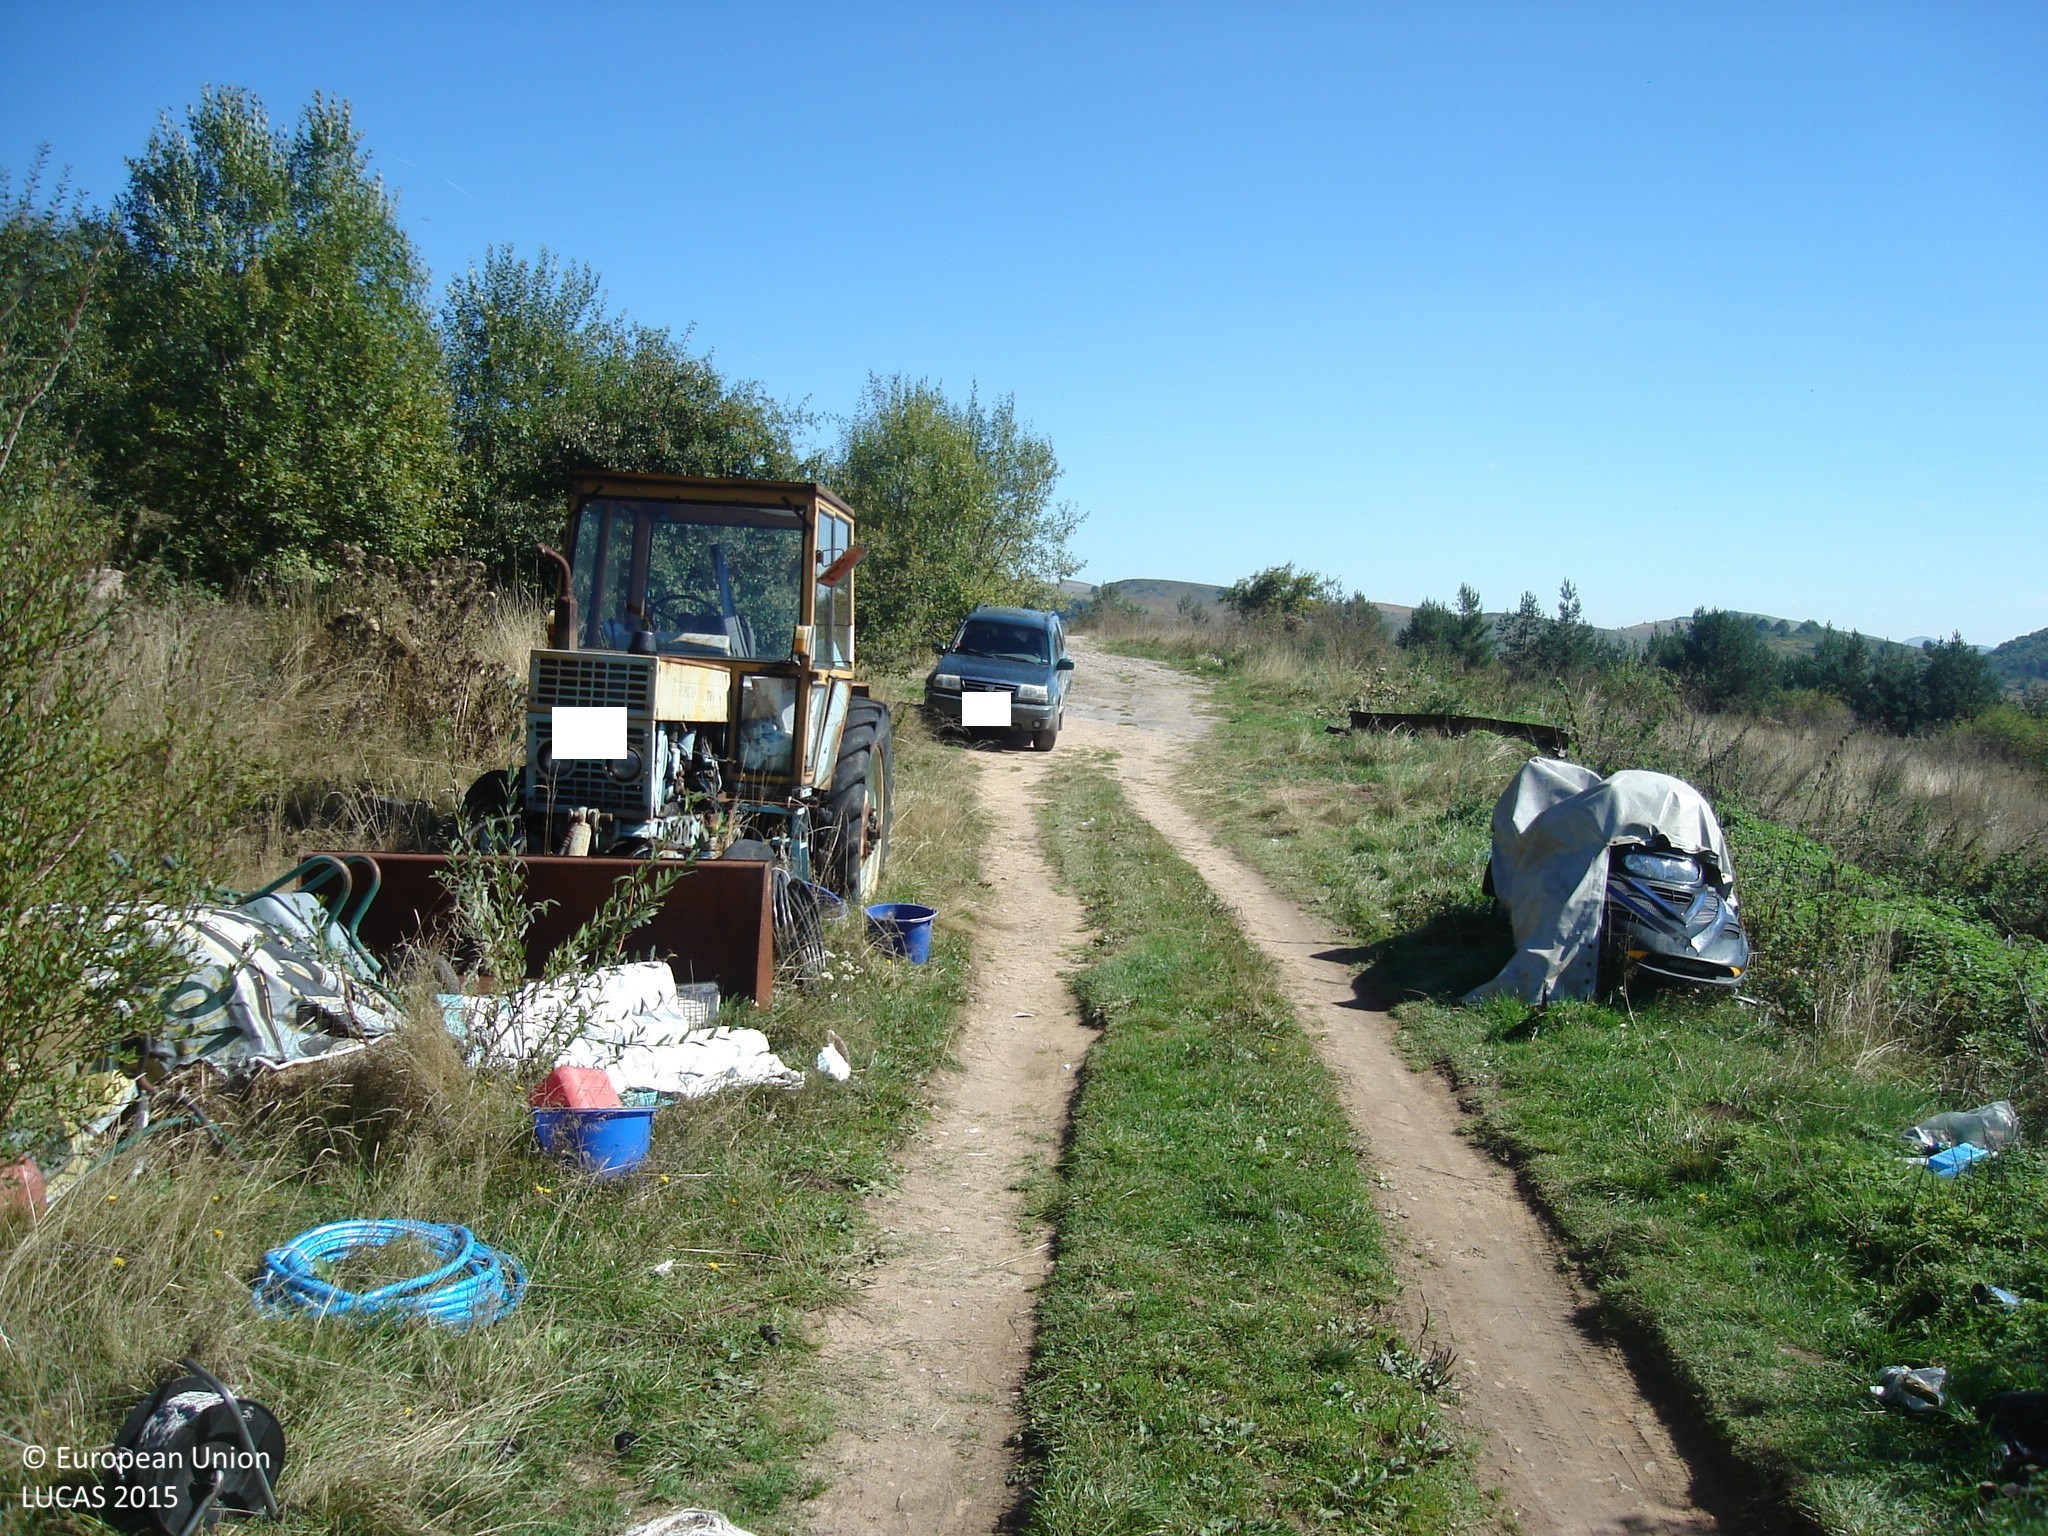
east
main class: Grassland
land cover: Grassland with sparse tree/shrub cover
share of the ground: 50 - 75 %
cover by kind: herbaceous plants 55 %, coniferous forest trees 5 %
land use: Residential
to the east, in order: Grassland with sparse tree/shrub cover; Tracks; Broadleaved woodland; Tracks; Pine dominated coniferous woodland; Shrubland with sparse tree cover; Tracks; Broadleaved woodland; Tracks; Shrubland with sparse tree cover; Pine dominated coniferous woodland
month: October
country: BG
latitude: 43.1082
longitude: 23.1473
